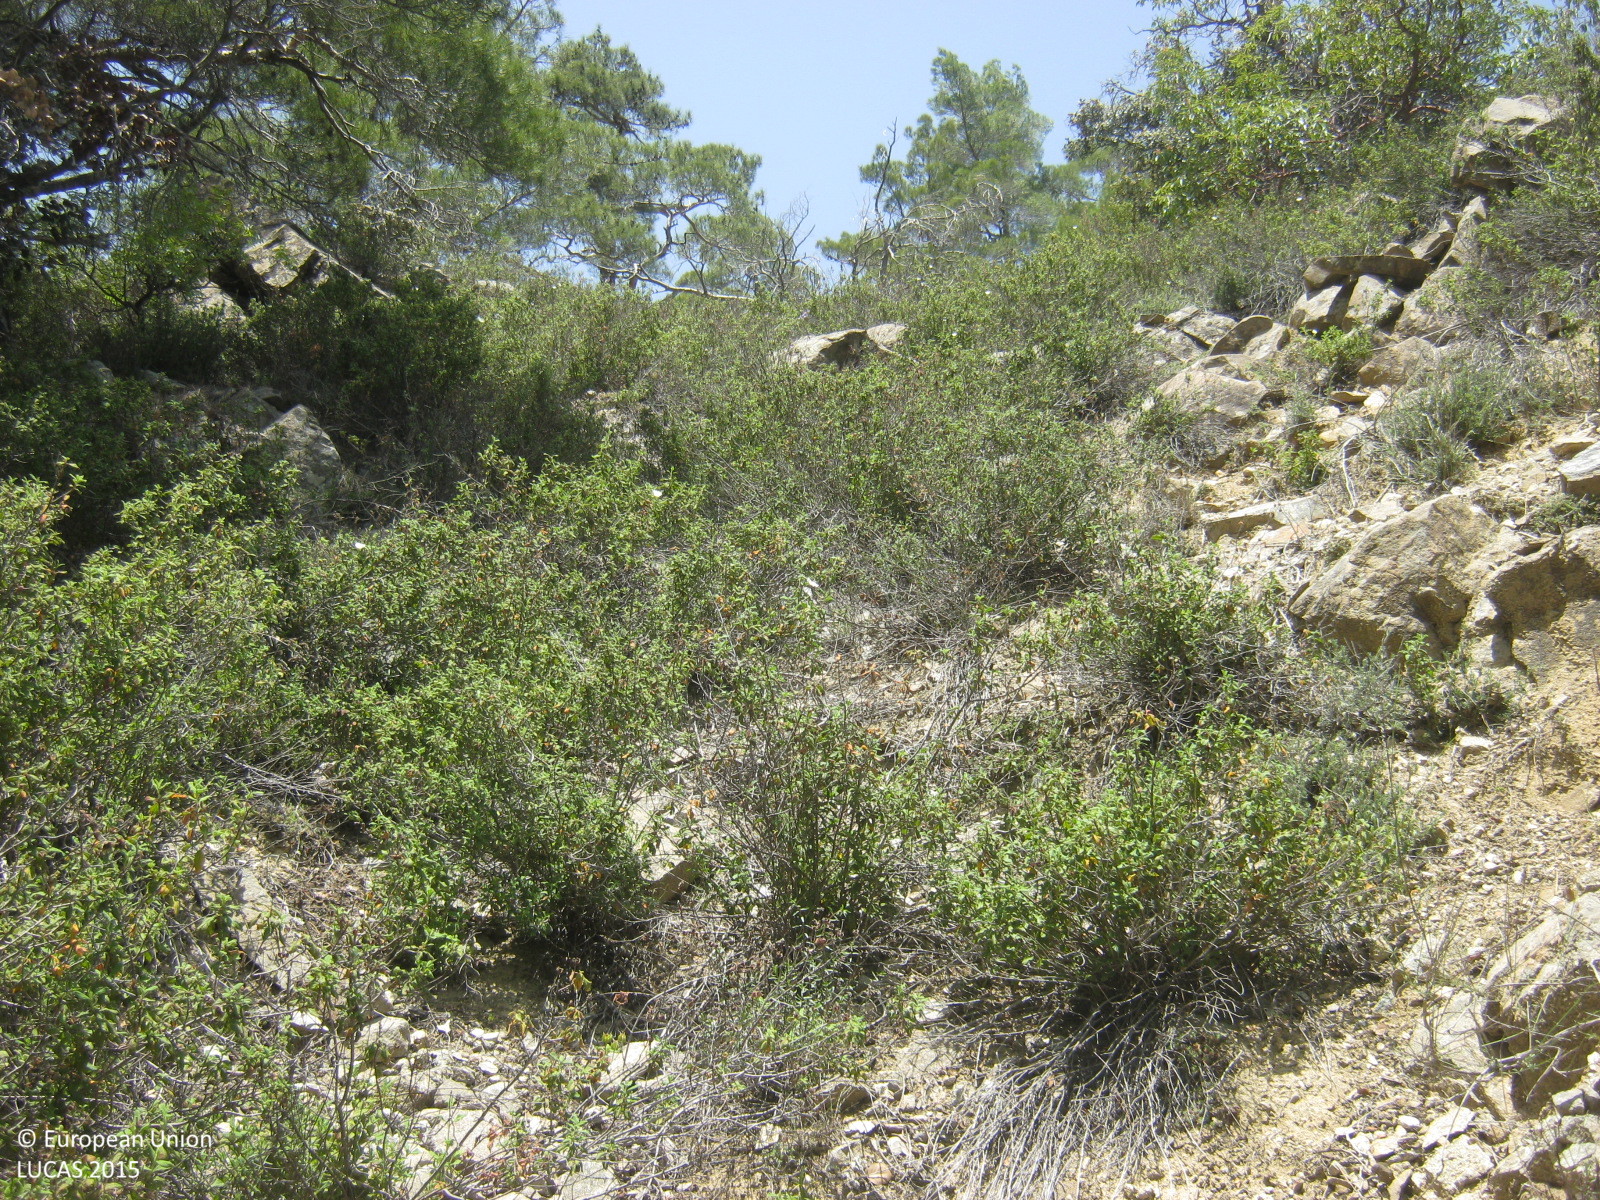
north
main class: Woodland
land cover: Pine dominated mixed woodland
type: coniferous forest of the mediterranean region
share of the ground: 50 - 75 %
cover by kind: coniferous forest trees 50 %, broadleaved forest trees 25 %, shrubs 10 %, consolidated bare surface 10 %, unconsolidated bare surface 5 %
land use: Forestry
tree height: > 5 m
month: May
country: CY
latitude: 34.9759
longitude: 32.8749
